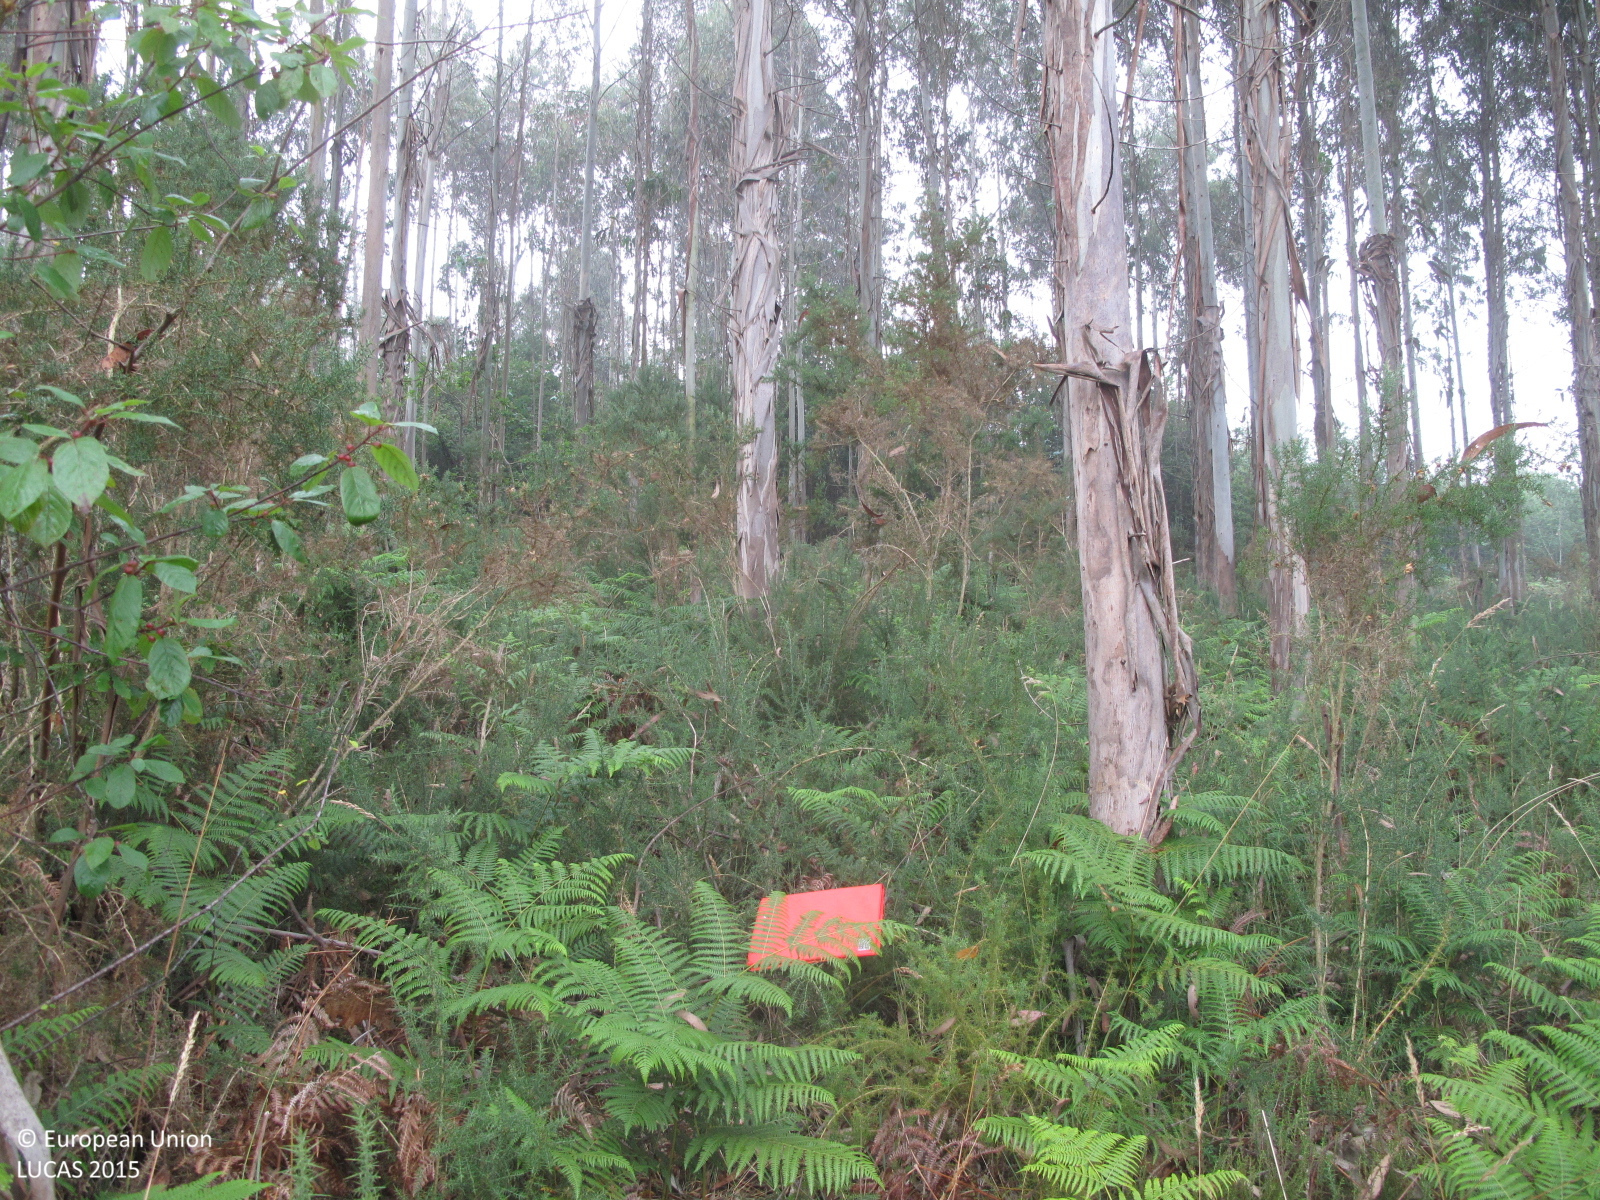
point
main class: Woodland
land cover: Broadleaved woodland
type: exotic forest
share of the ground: 50 - 75 %
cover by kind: broadleaved forest trees 60 %, shrubs 20 %, herbaceous plants 20 %
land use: Forestry
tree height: > 5 m
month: June
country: ES
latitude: 43.1425
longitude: -8.2341
